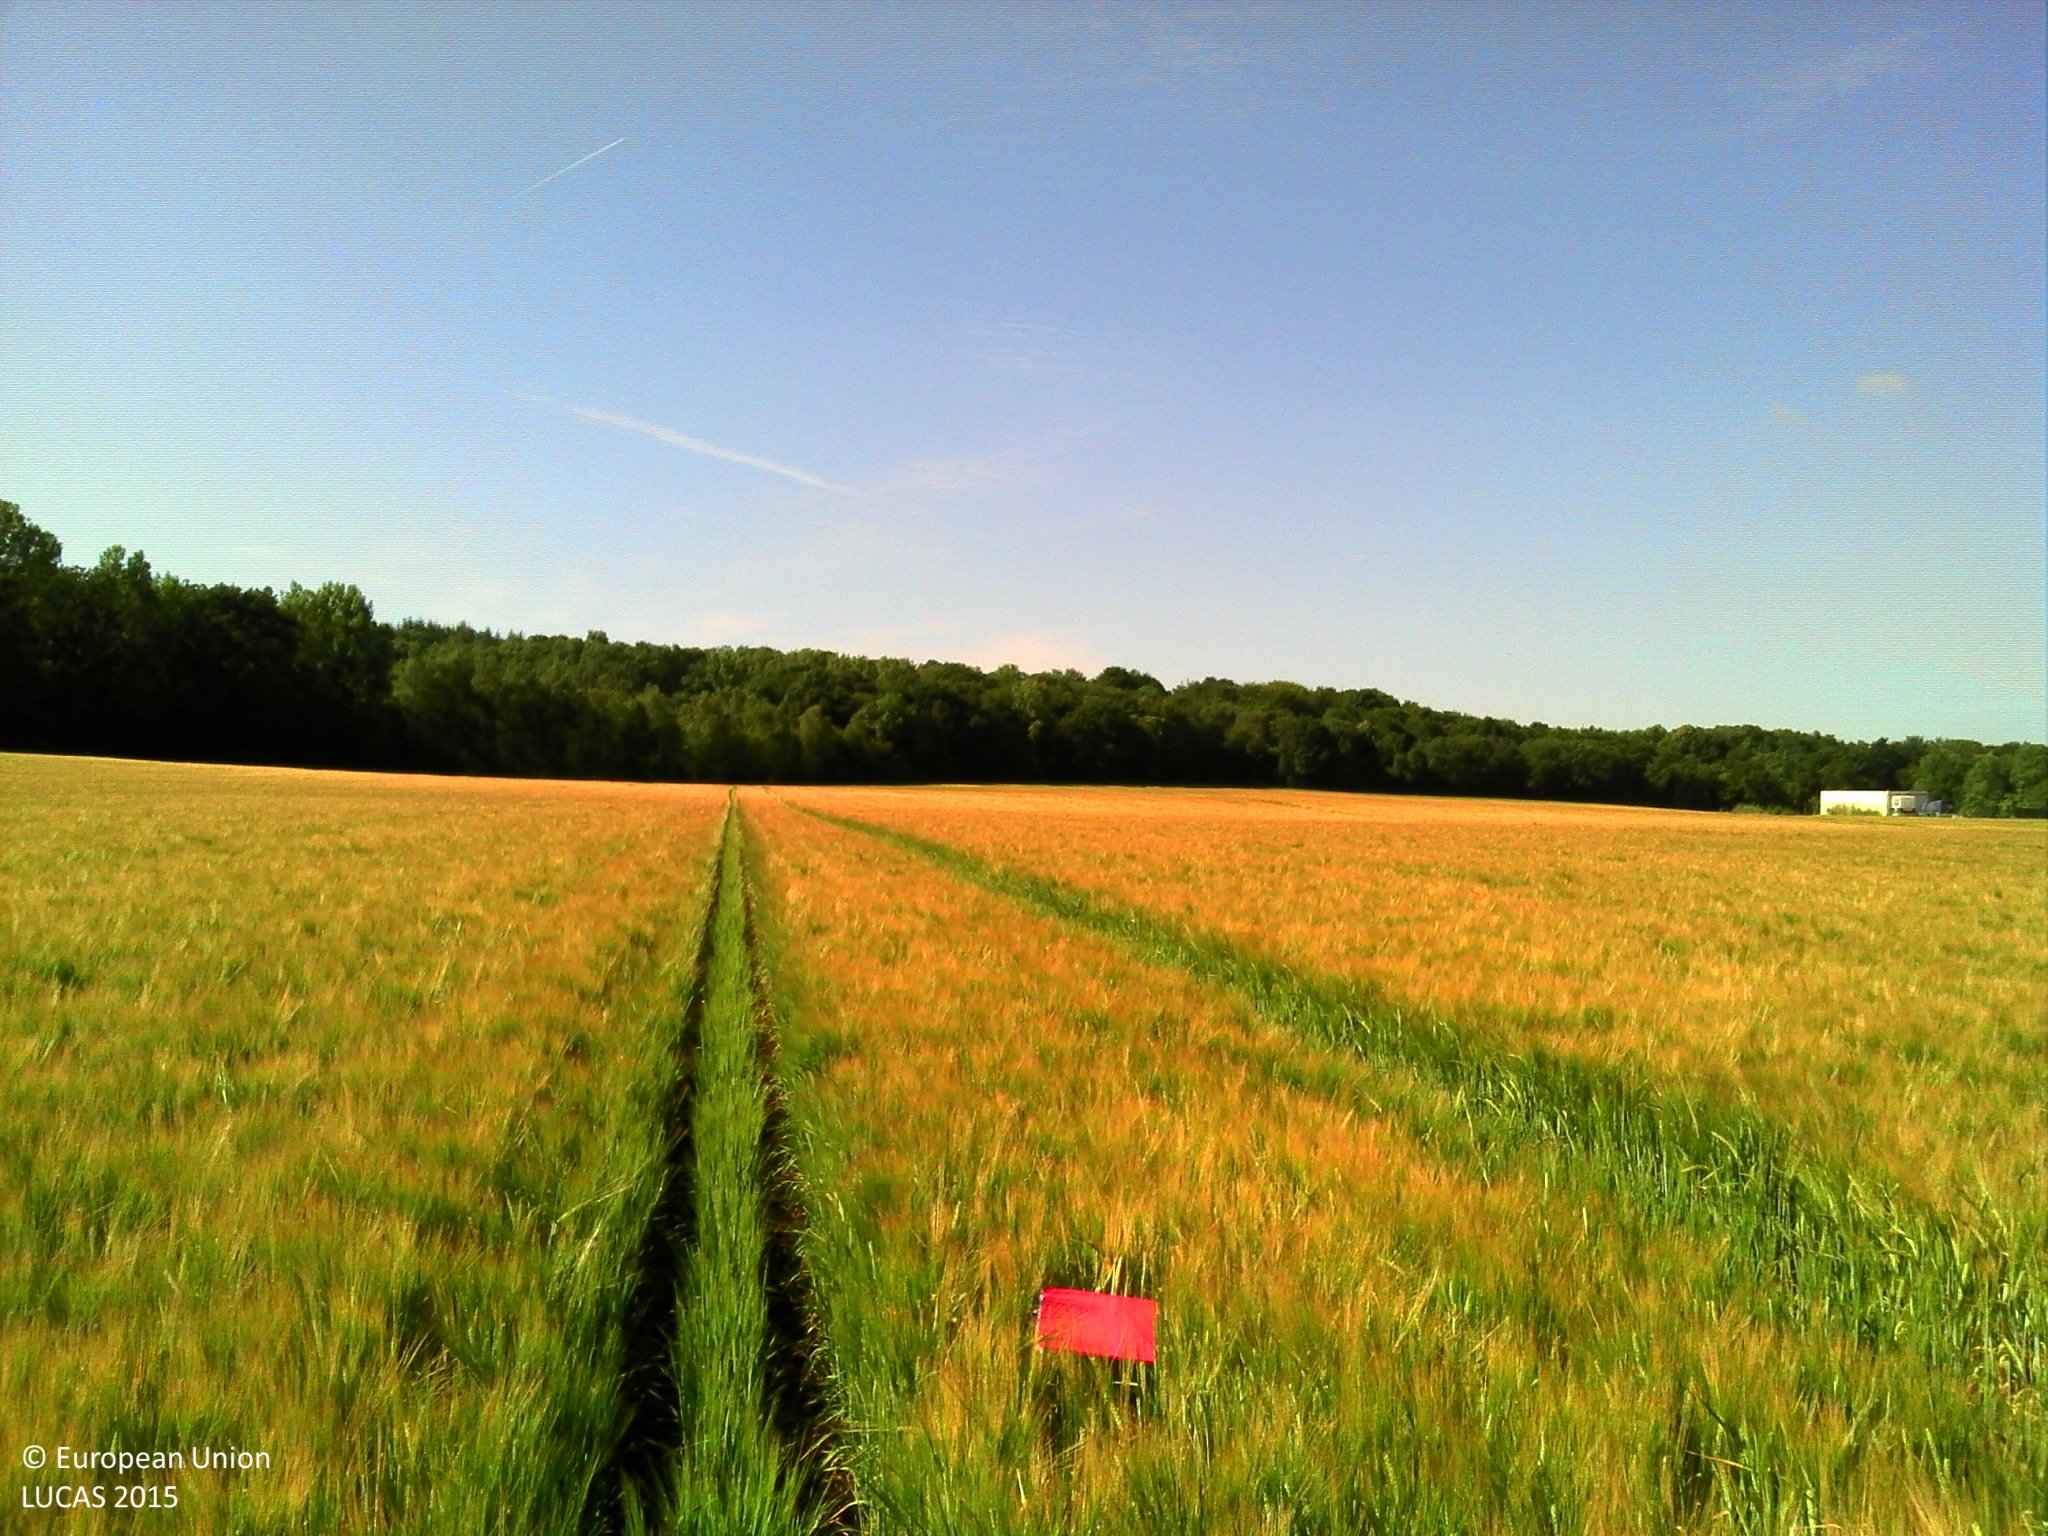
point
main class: Cropland
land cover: Barley
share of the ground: > 75 %
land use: Agriculture (excluding fallow land and kitchen gardens)
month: June
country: FR
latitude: 49.2238
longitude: 2.9192
